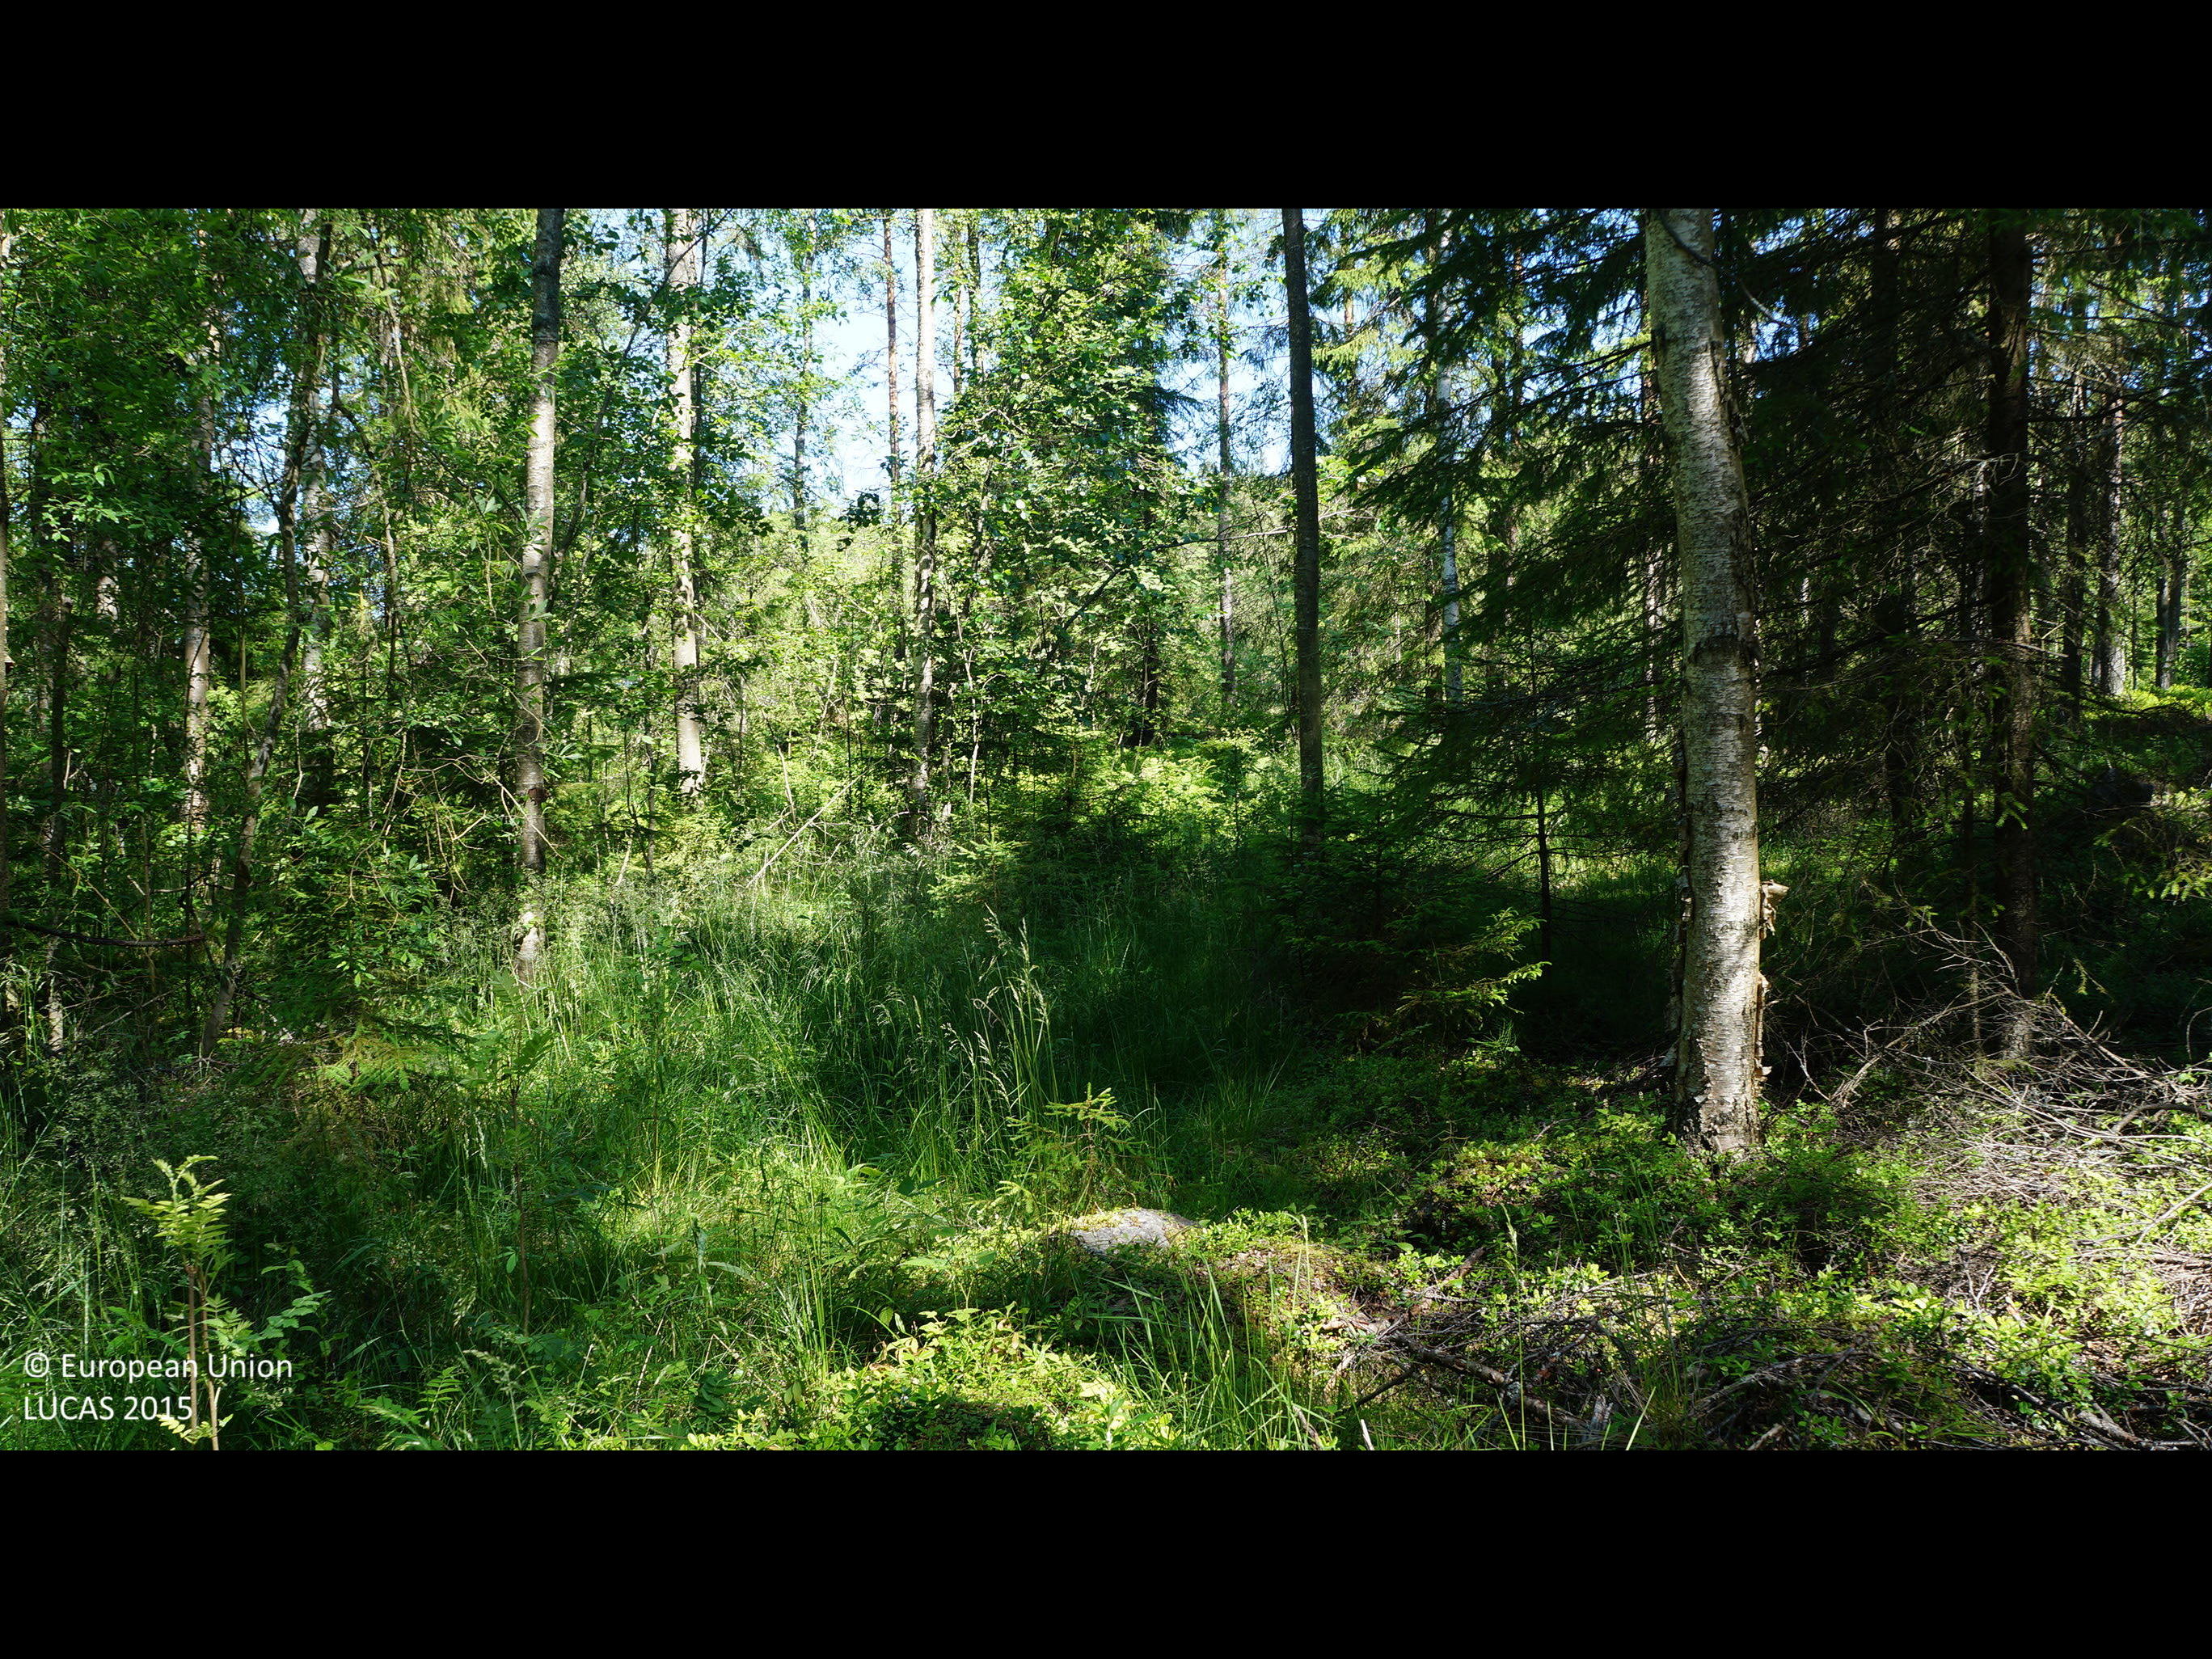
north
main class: Woodland
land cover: Spruce dominated mixed woodland
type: boreal forest
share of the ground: 50 - 75 %
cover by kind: coniferous forest trees 40 %, shrubs 25 %, broadleaved forest trees 20 %, herbaceous plants 15 %
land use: Forestry
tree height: > 5 m
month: July
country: FI
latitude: 63.7959
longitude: 22.8986
